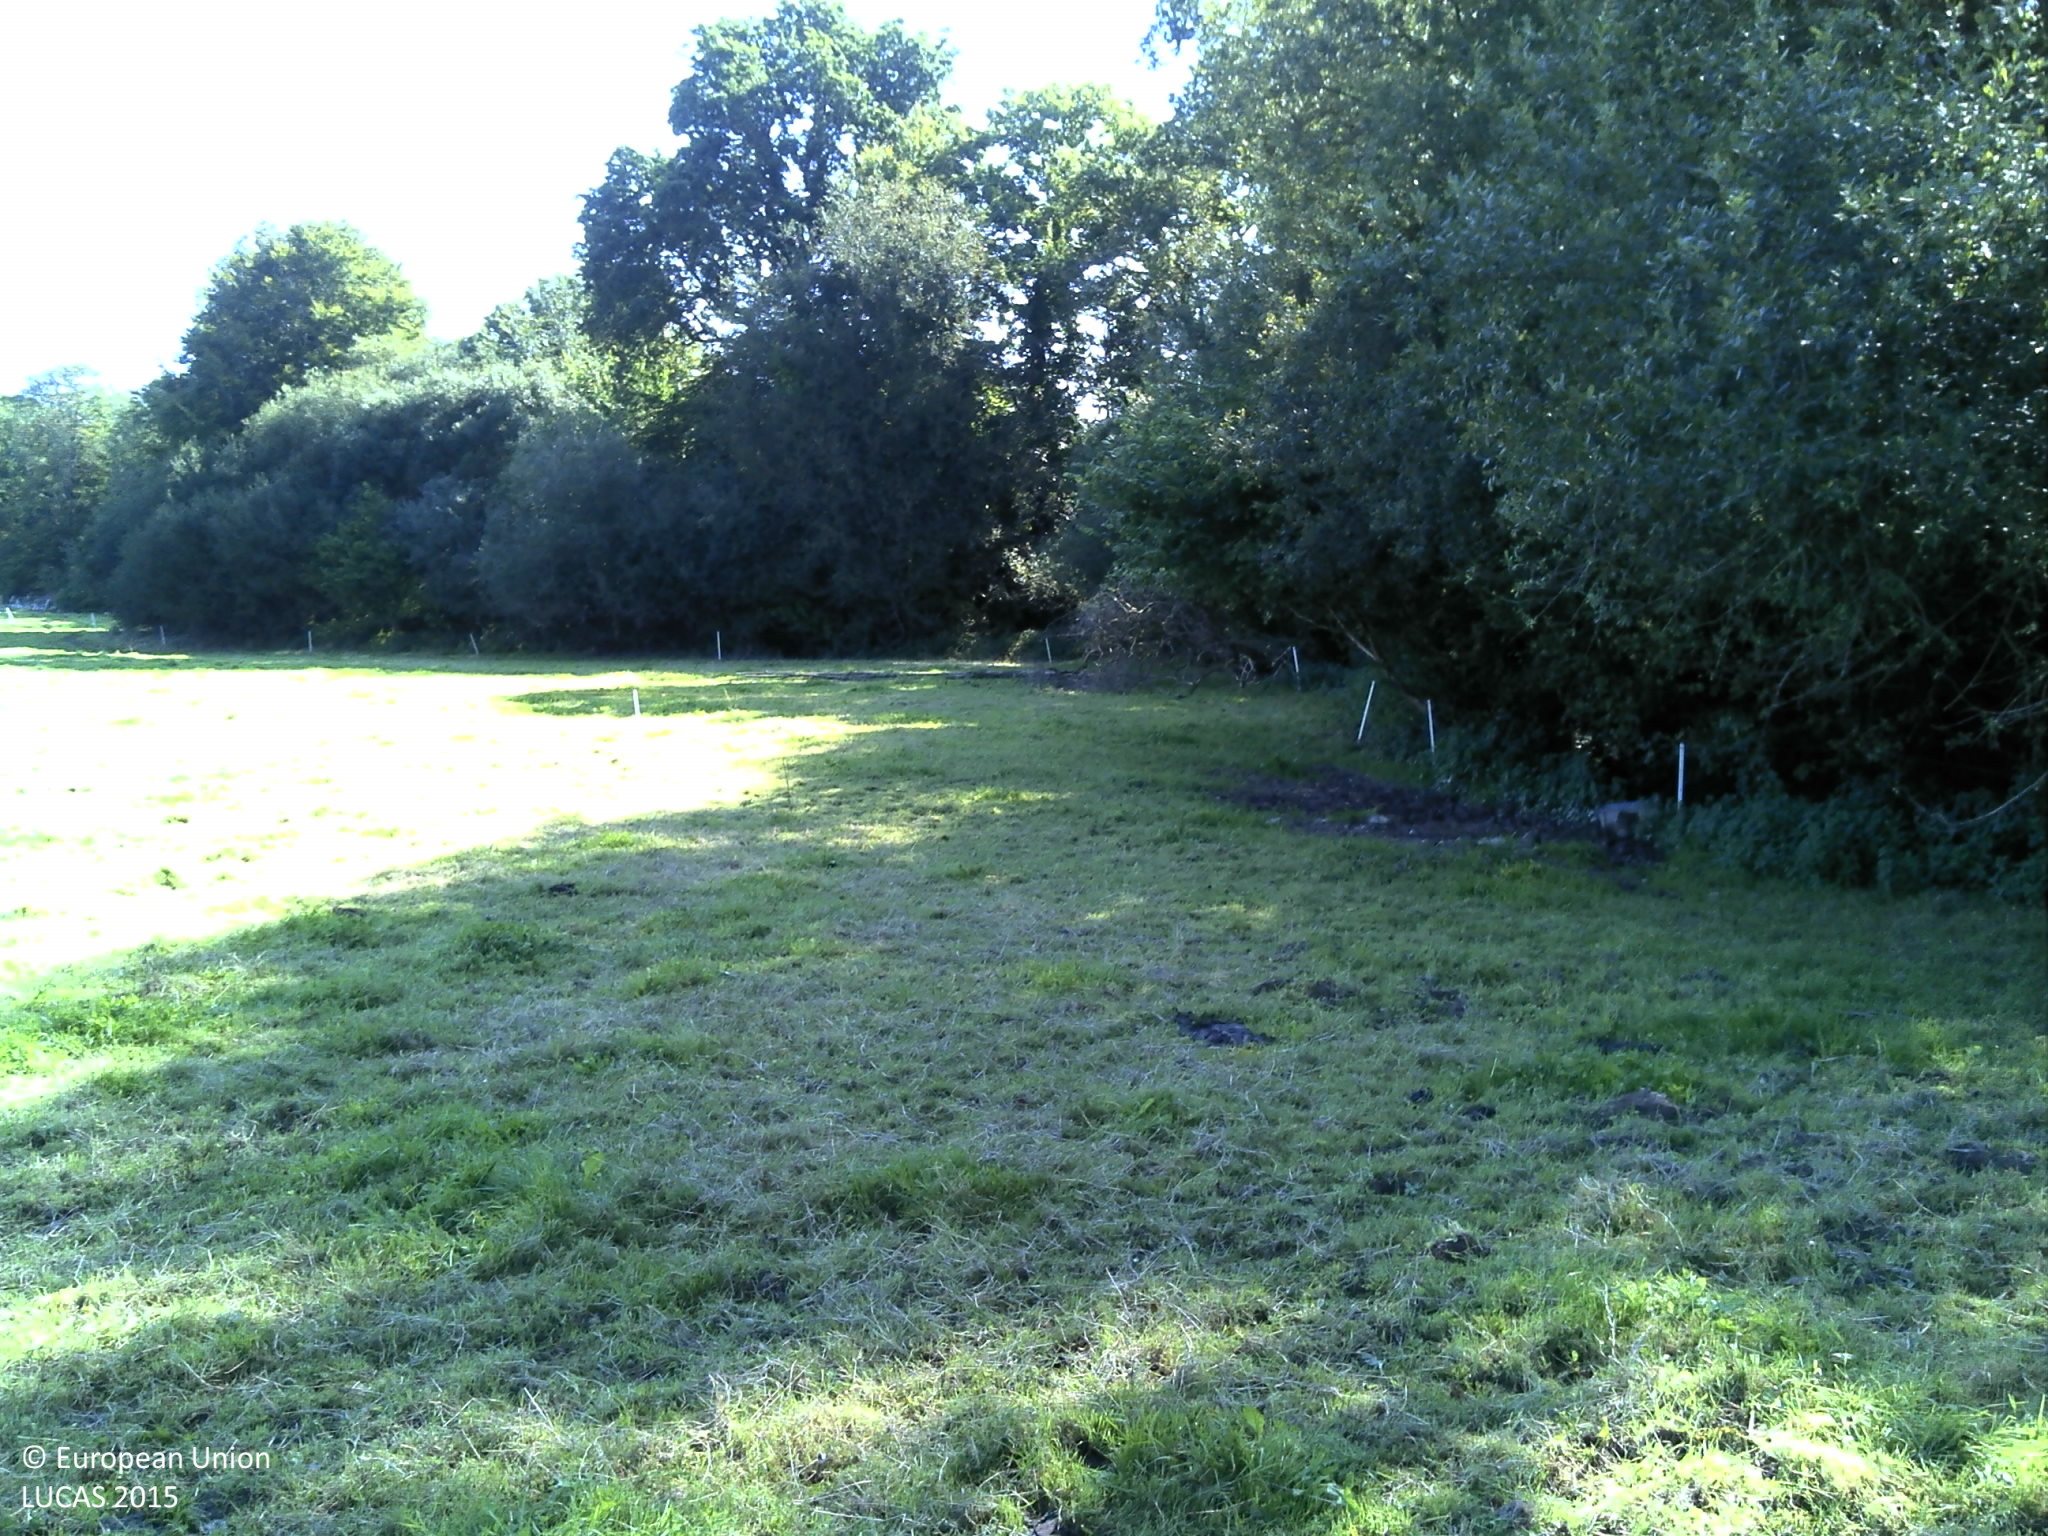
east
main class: Grassland
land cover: Grassland without tree/shrub cover
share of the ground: > 75 %
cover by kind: herbaceous plants 100 %
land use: Agriculture (excluding fallow land and kitchen gardens)
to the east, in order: Grassland without tree/shrub cover; Fences; Grassland without tree/shrub cover; Fences; Broadleaved woodland; Rivers and streams; Broadleaved woodland; Shrubland with sparse tree cover; Broadleaved woodland
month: September
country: FR
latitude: 48.1648
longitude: -4.1403
